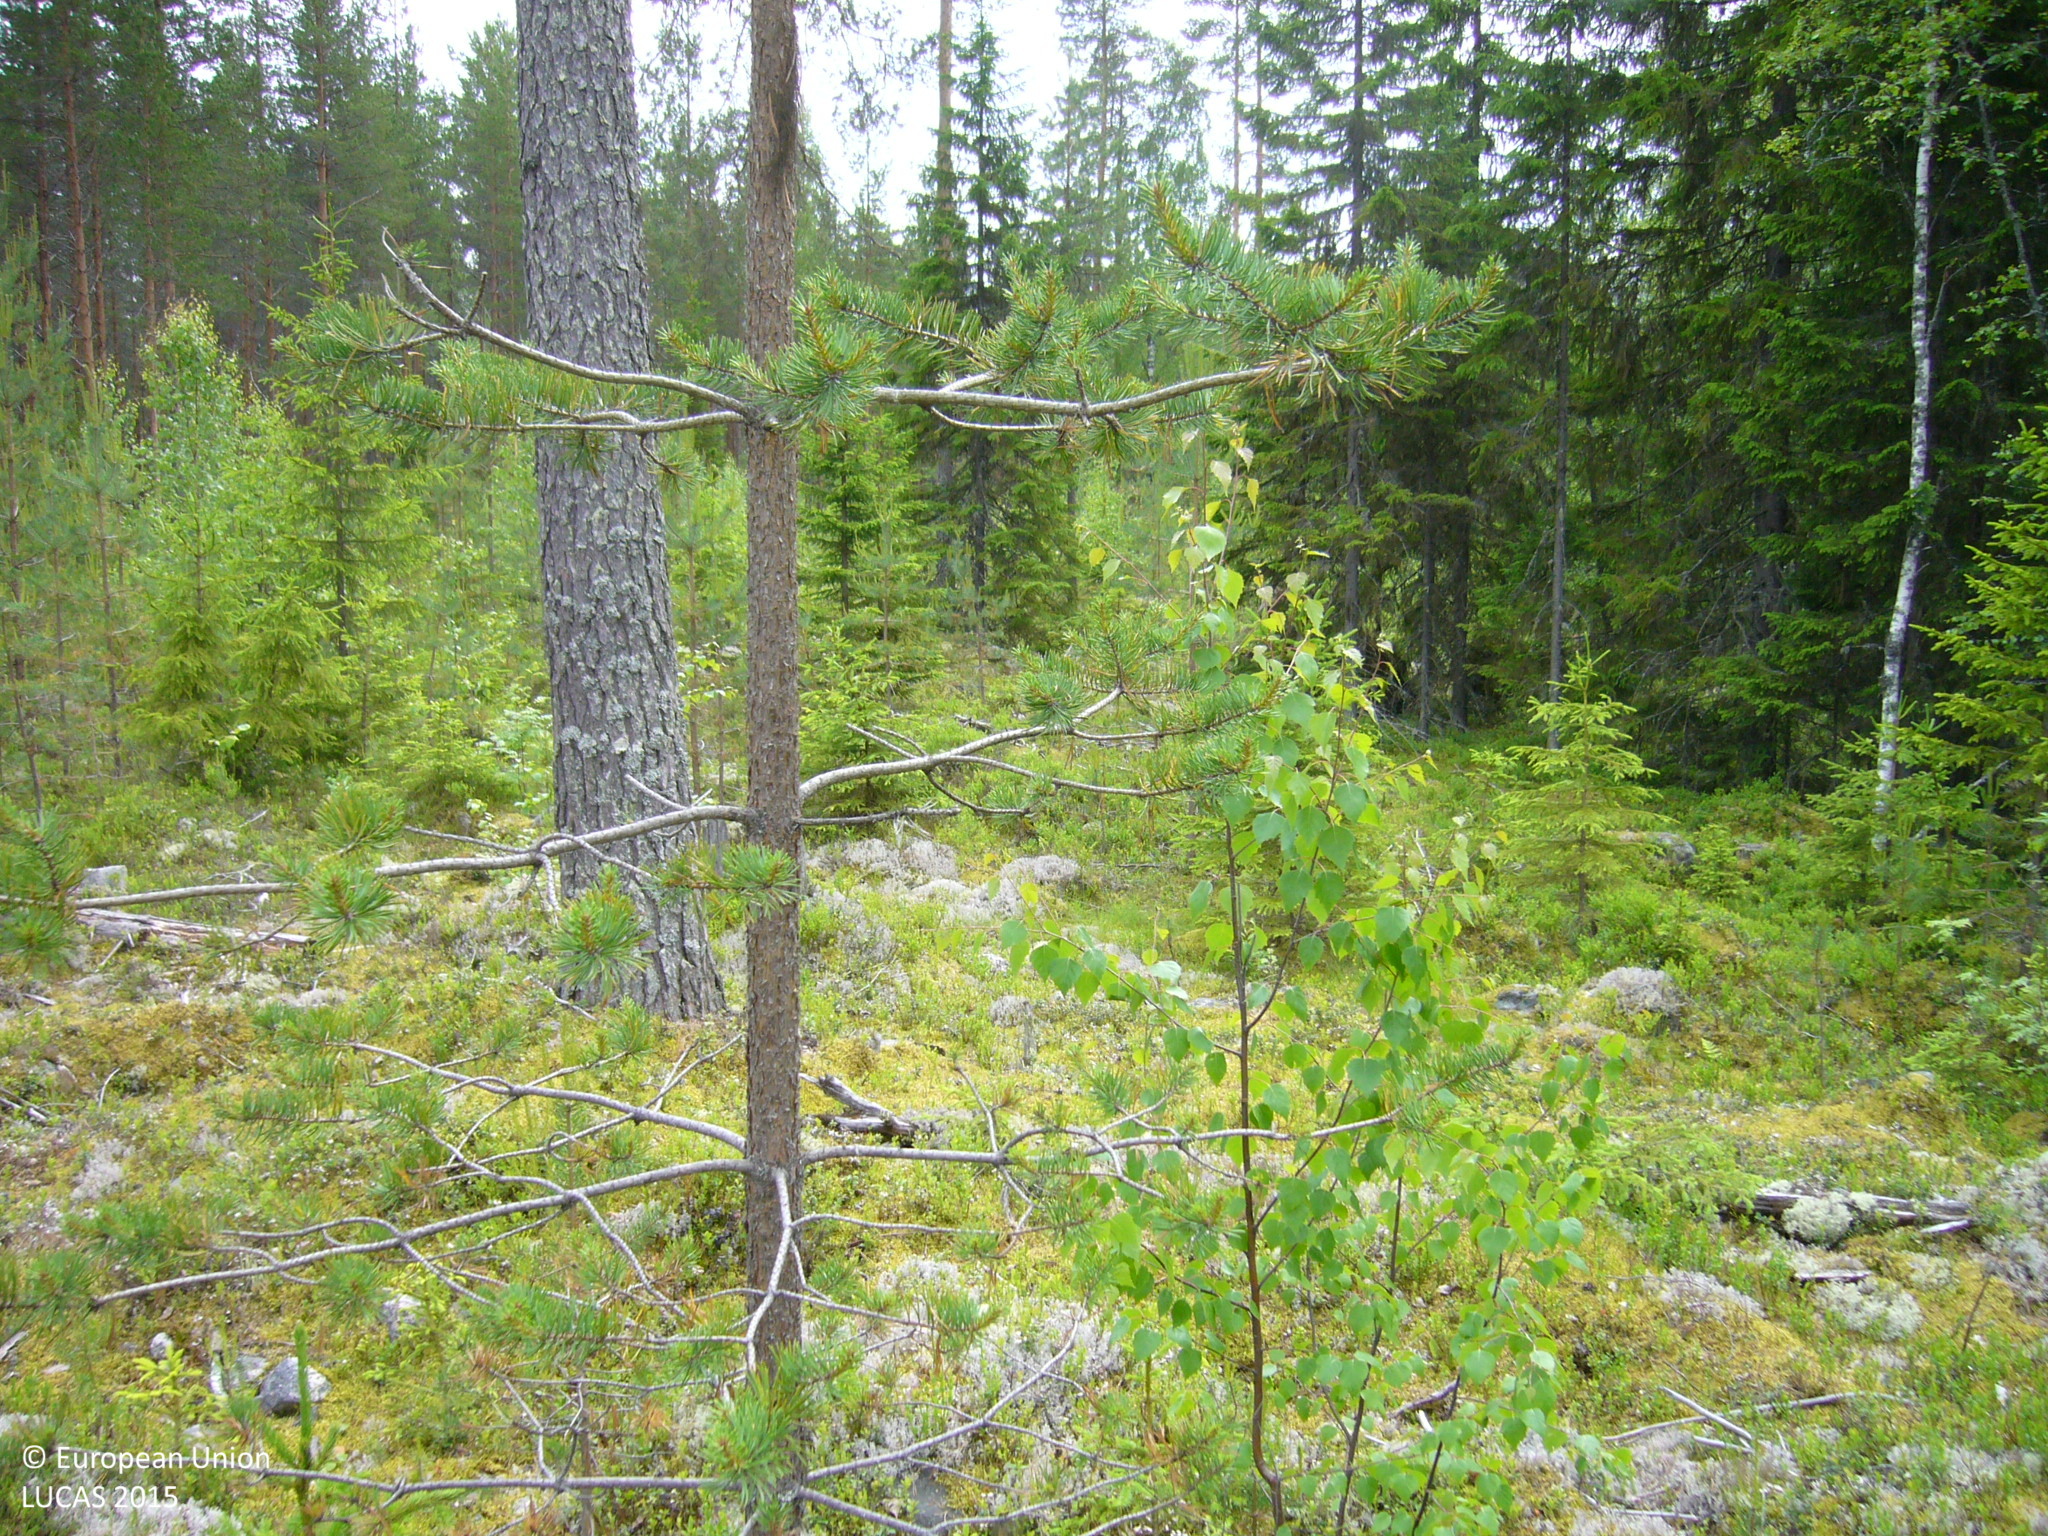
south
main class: Woodland
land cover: Pine dominated coniferous woodland
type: boreal forest
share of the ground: 50 - 75 %
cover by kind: coniferous forest trees 50 %, lichens and mosses 40 %, shrubs 10 %
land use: Forestry
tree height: > 5 m
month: July
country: FI
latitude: 63.4349
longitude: 26.1314
